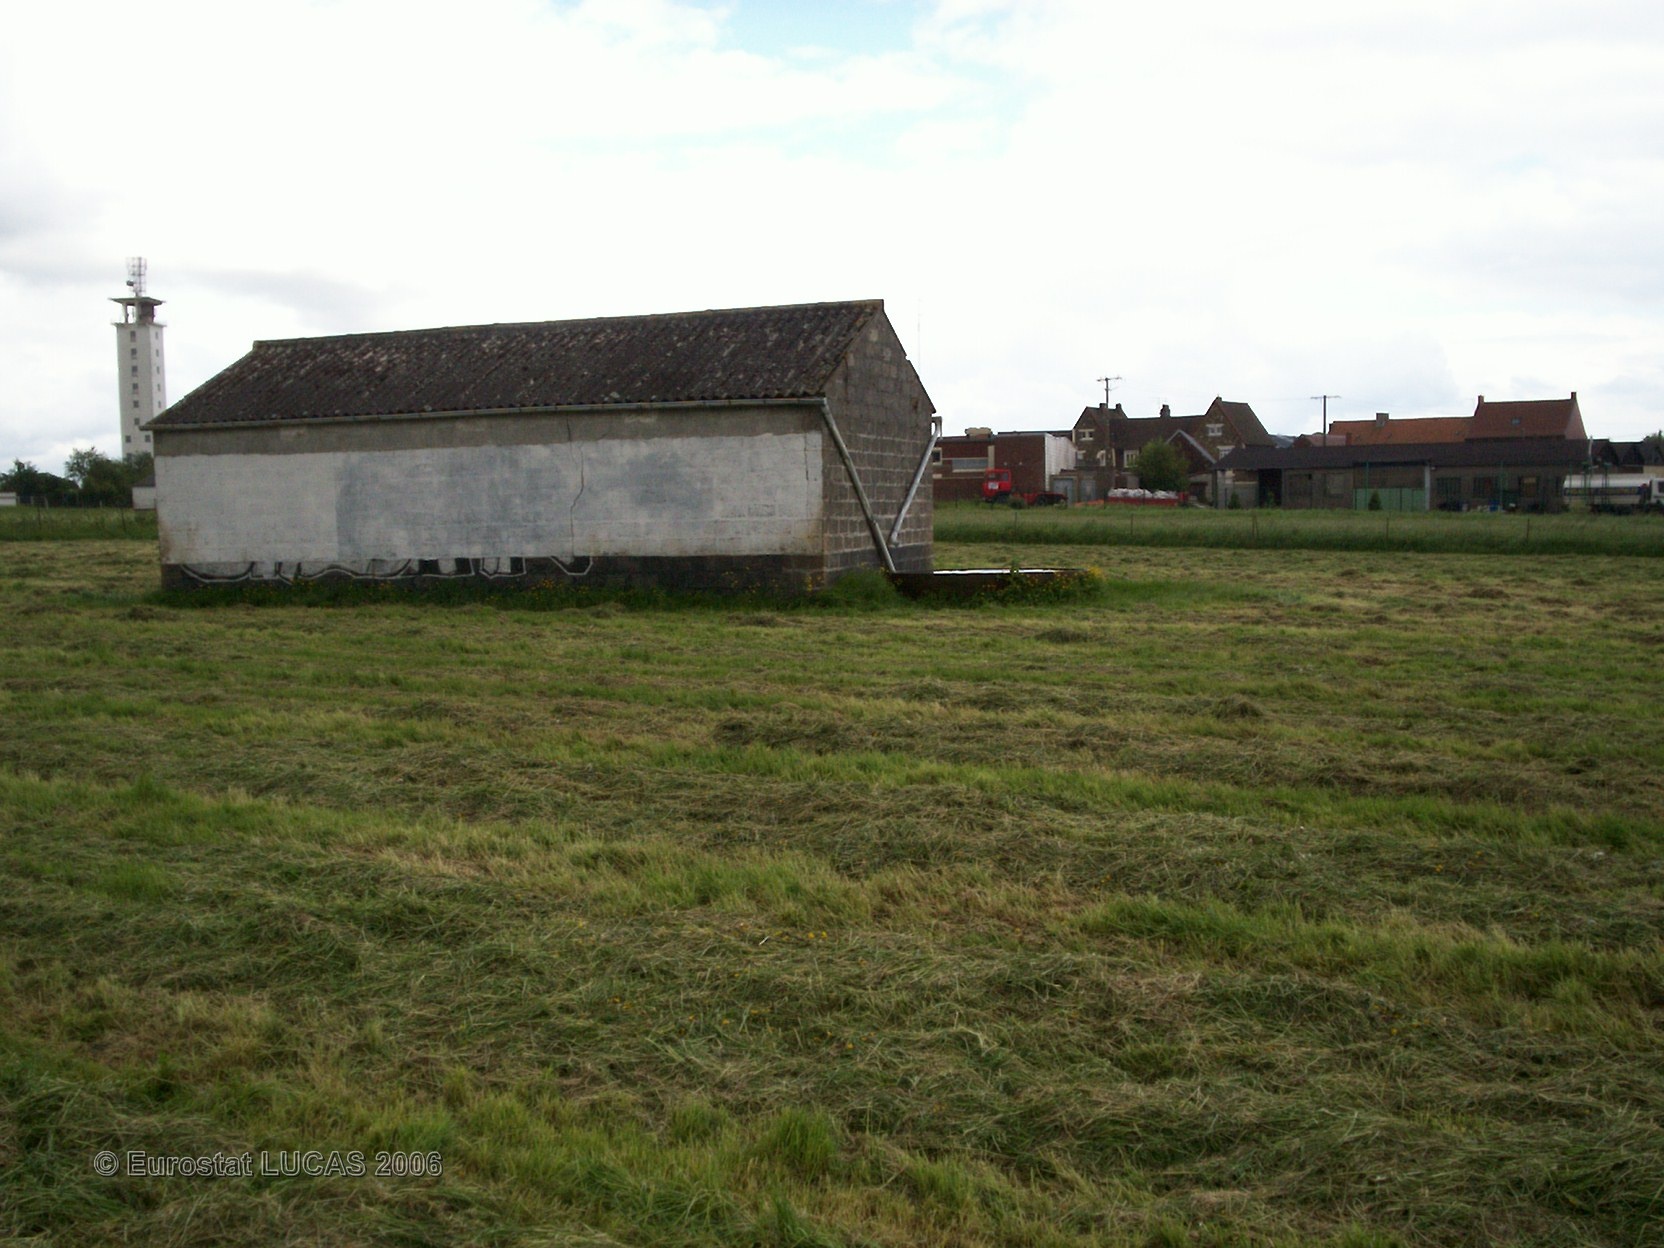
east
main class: Grassland
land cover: Grassland without tree/shrub cover
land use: Agriculture (excluding fallow land and kitchen gardens)
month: May
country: FR
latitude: 50.2110
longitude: 2.5470
